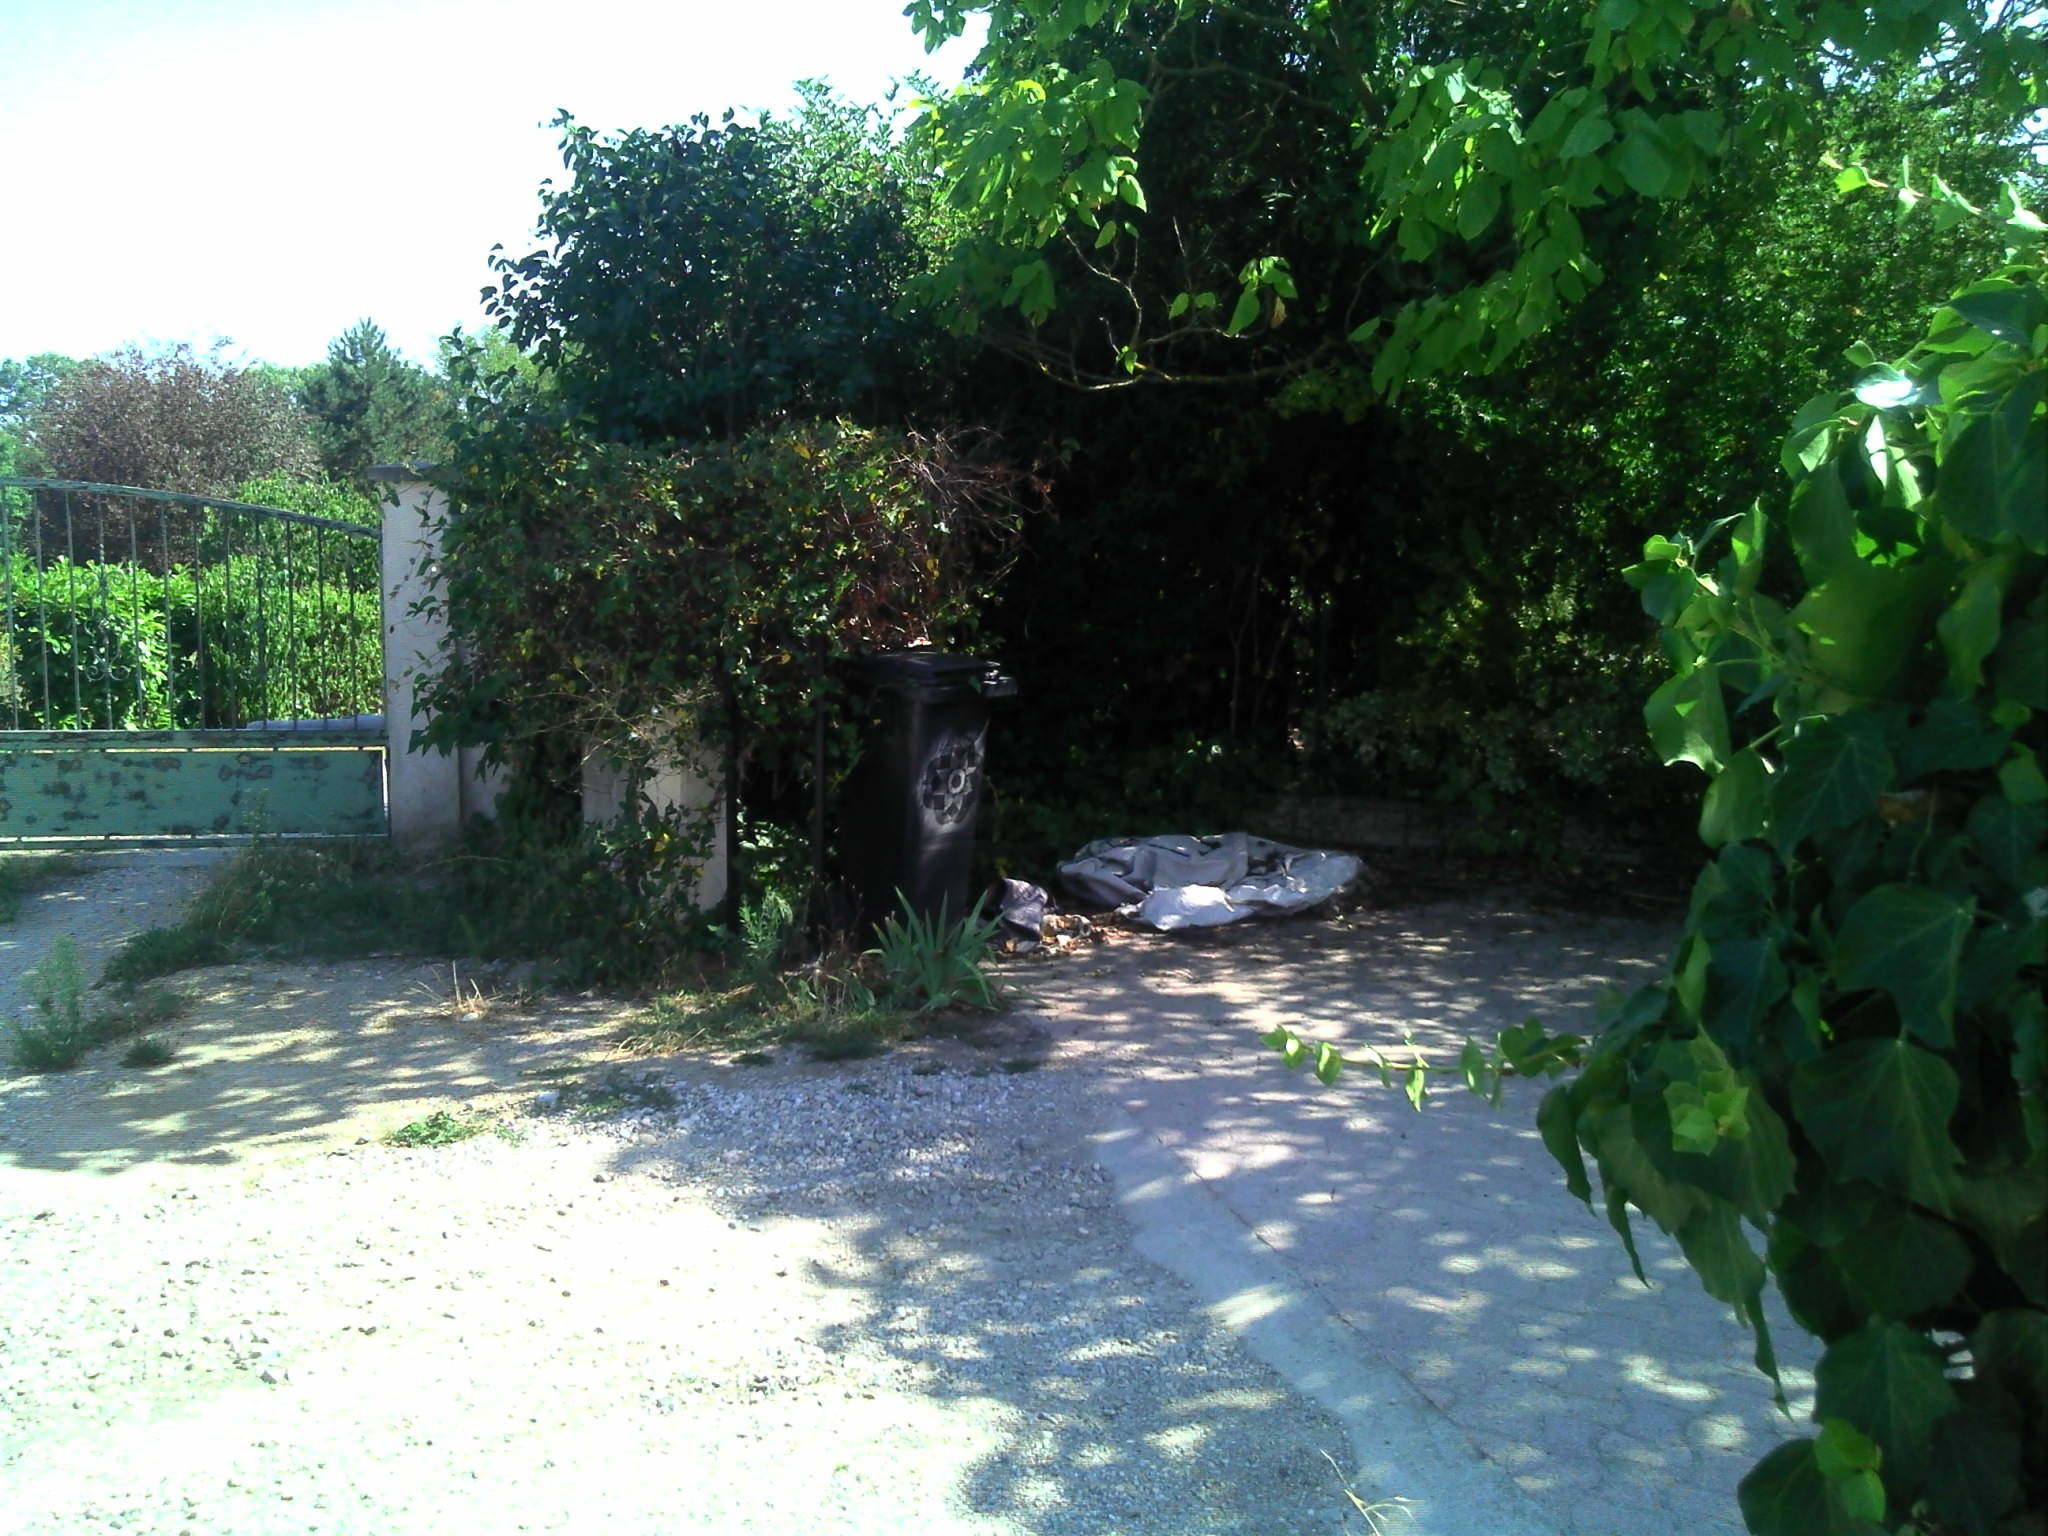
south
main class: Grassland
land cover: Grassland without tree/shrub cover
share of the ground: > 75 %
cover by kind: herbaceous plants 100 %
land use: Residential
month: August
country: FR
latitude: 45.6065
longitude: 4.7084
